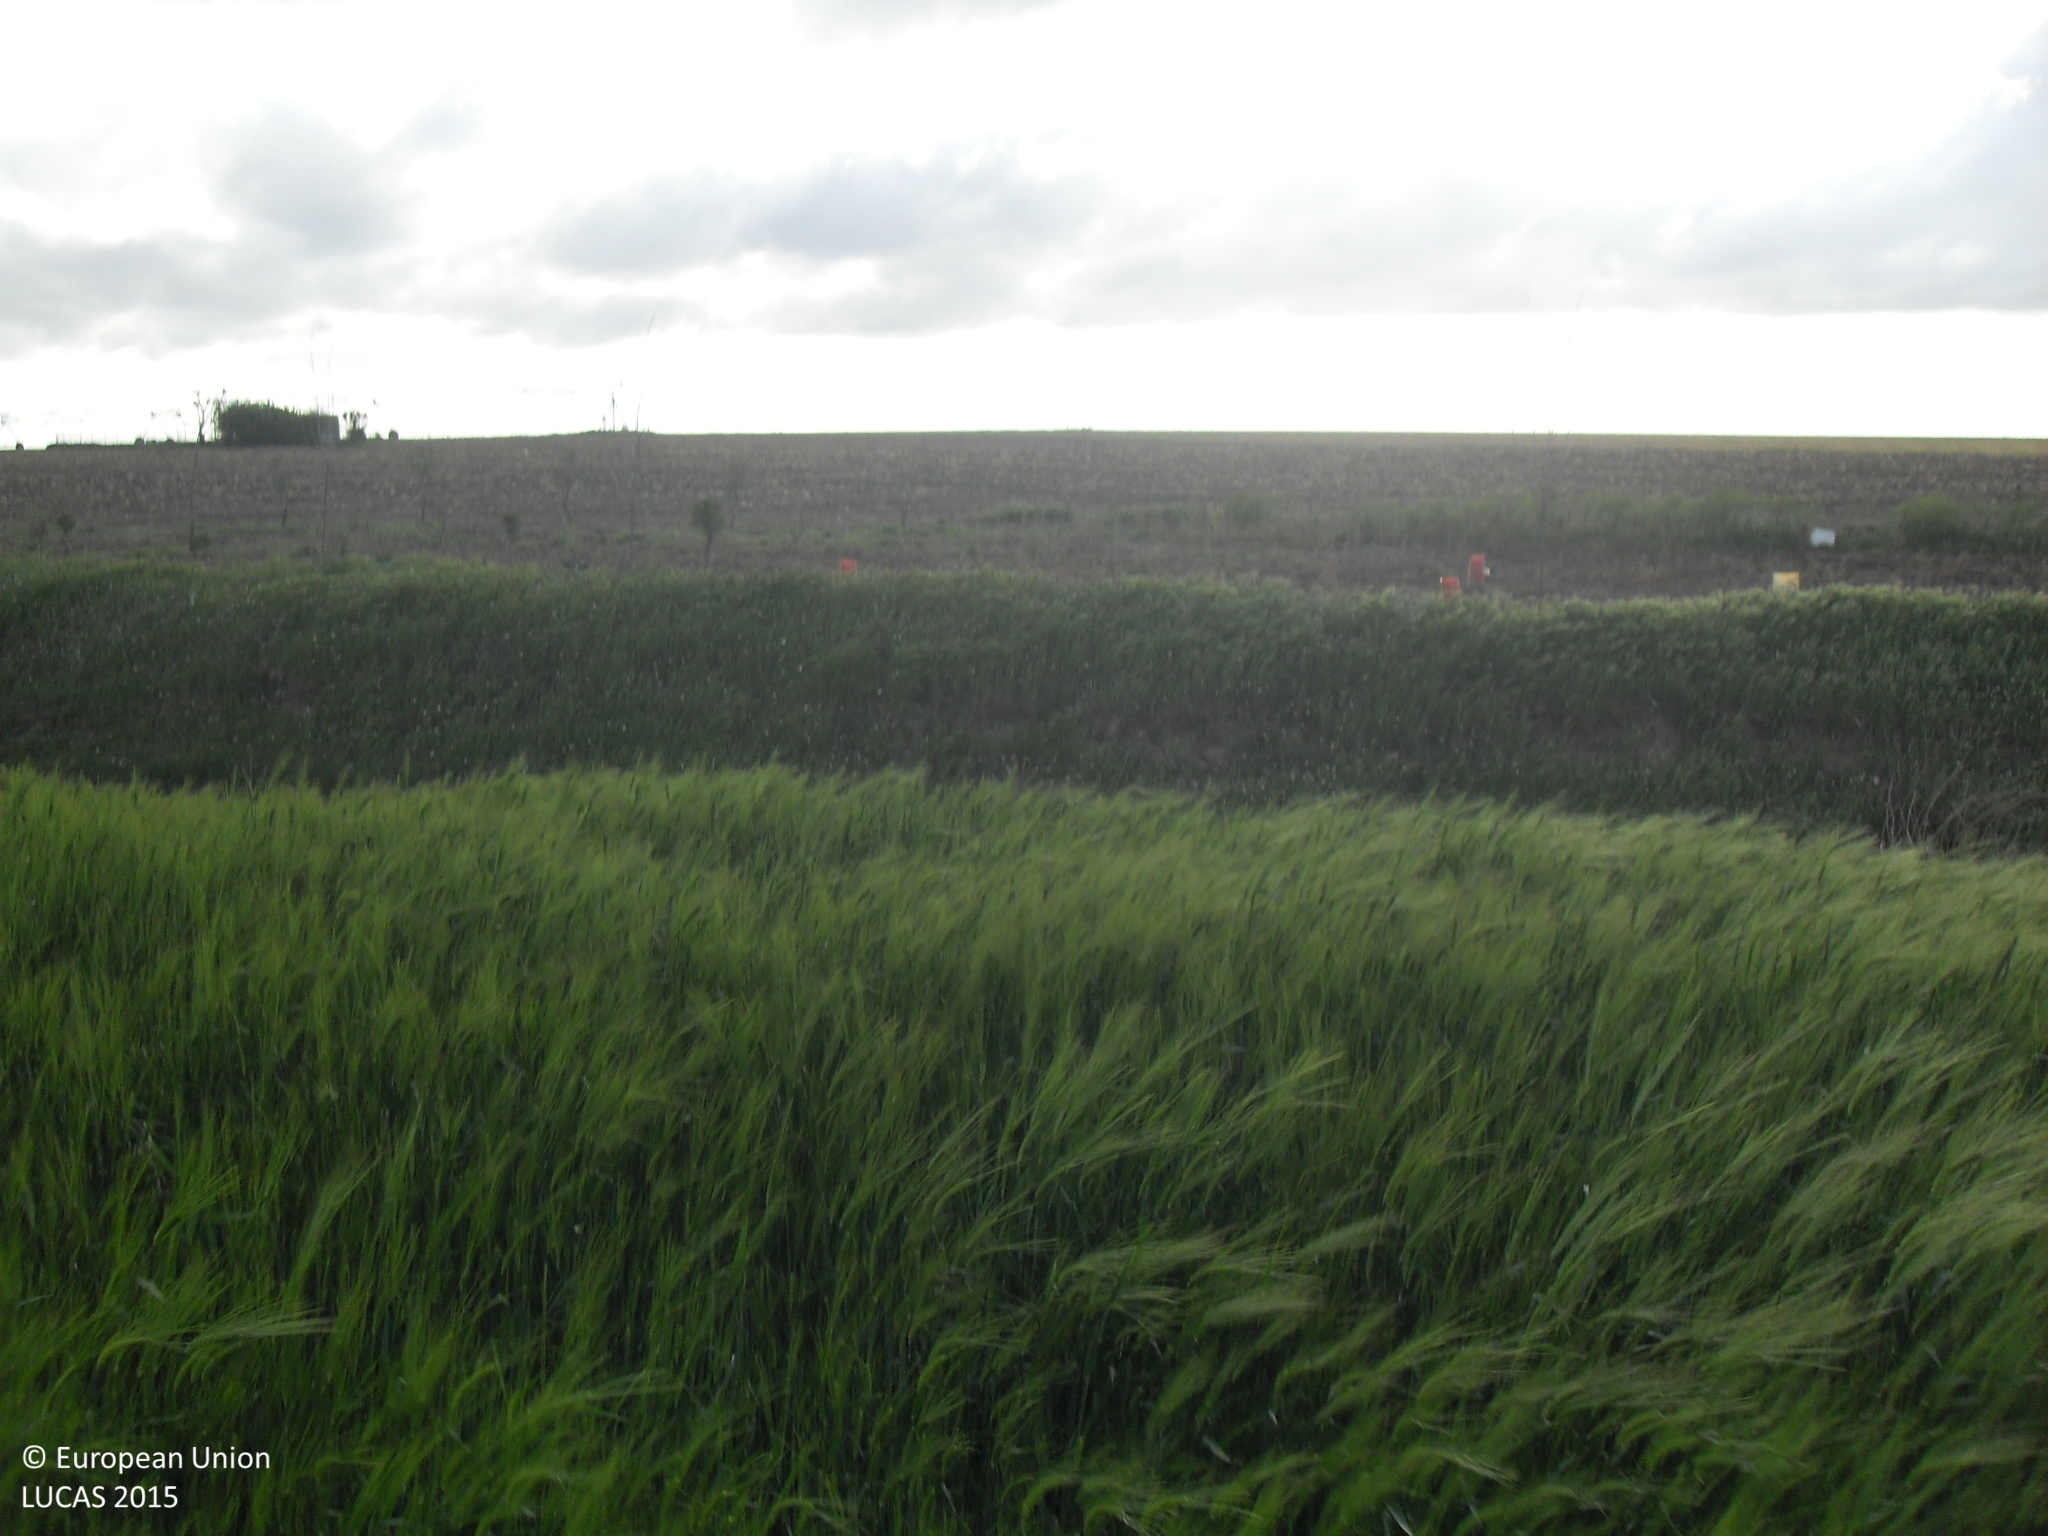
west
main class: Cropland
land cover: Barley
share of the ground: > 75 %
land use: Agriculture (excluding fallow land and kitchen gardens)
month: May
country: ES
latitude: 40.9713
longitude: -5.1718
